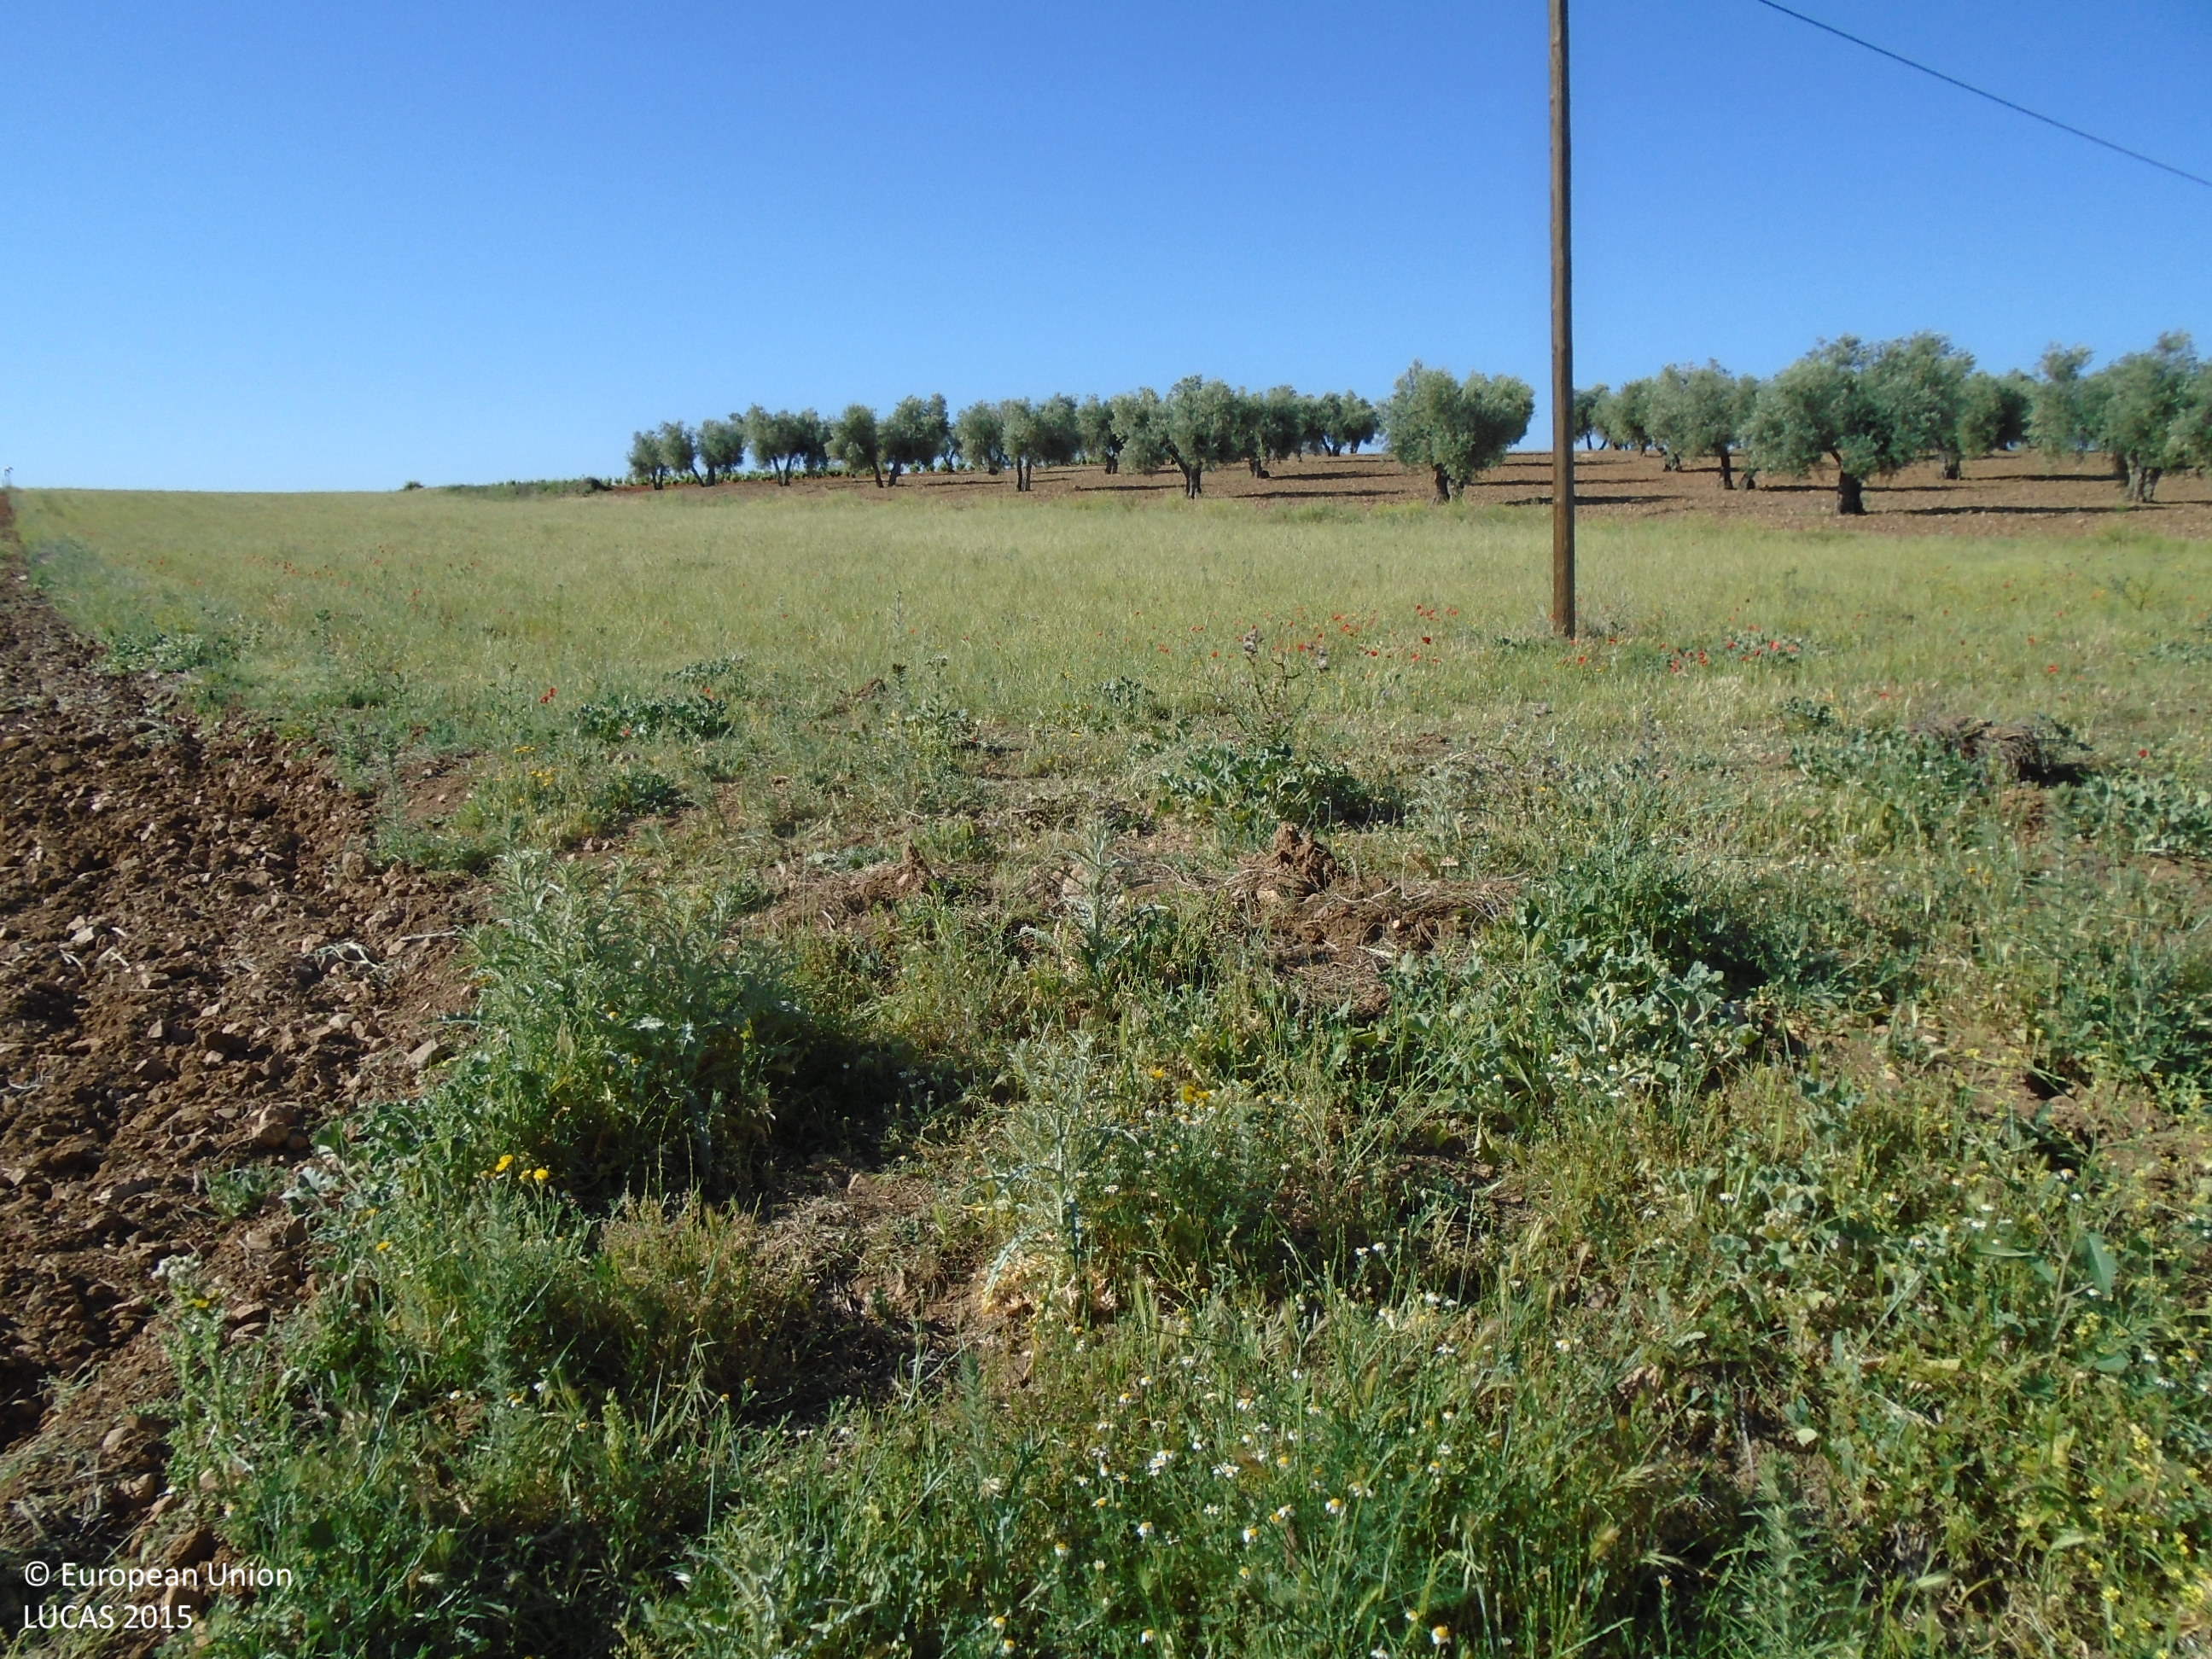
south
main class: Grassland
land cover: Spontaneously vegetated surfaces
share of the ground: > 75 %
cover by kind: herbaceous plants 95 %, consolidated bare surface 5 %
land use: Semi-natural and natural areas not in use
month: May
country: ES
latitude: 39.7177
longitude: -3.7354
